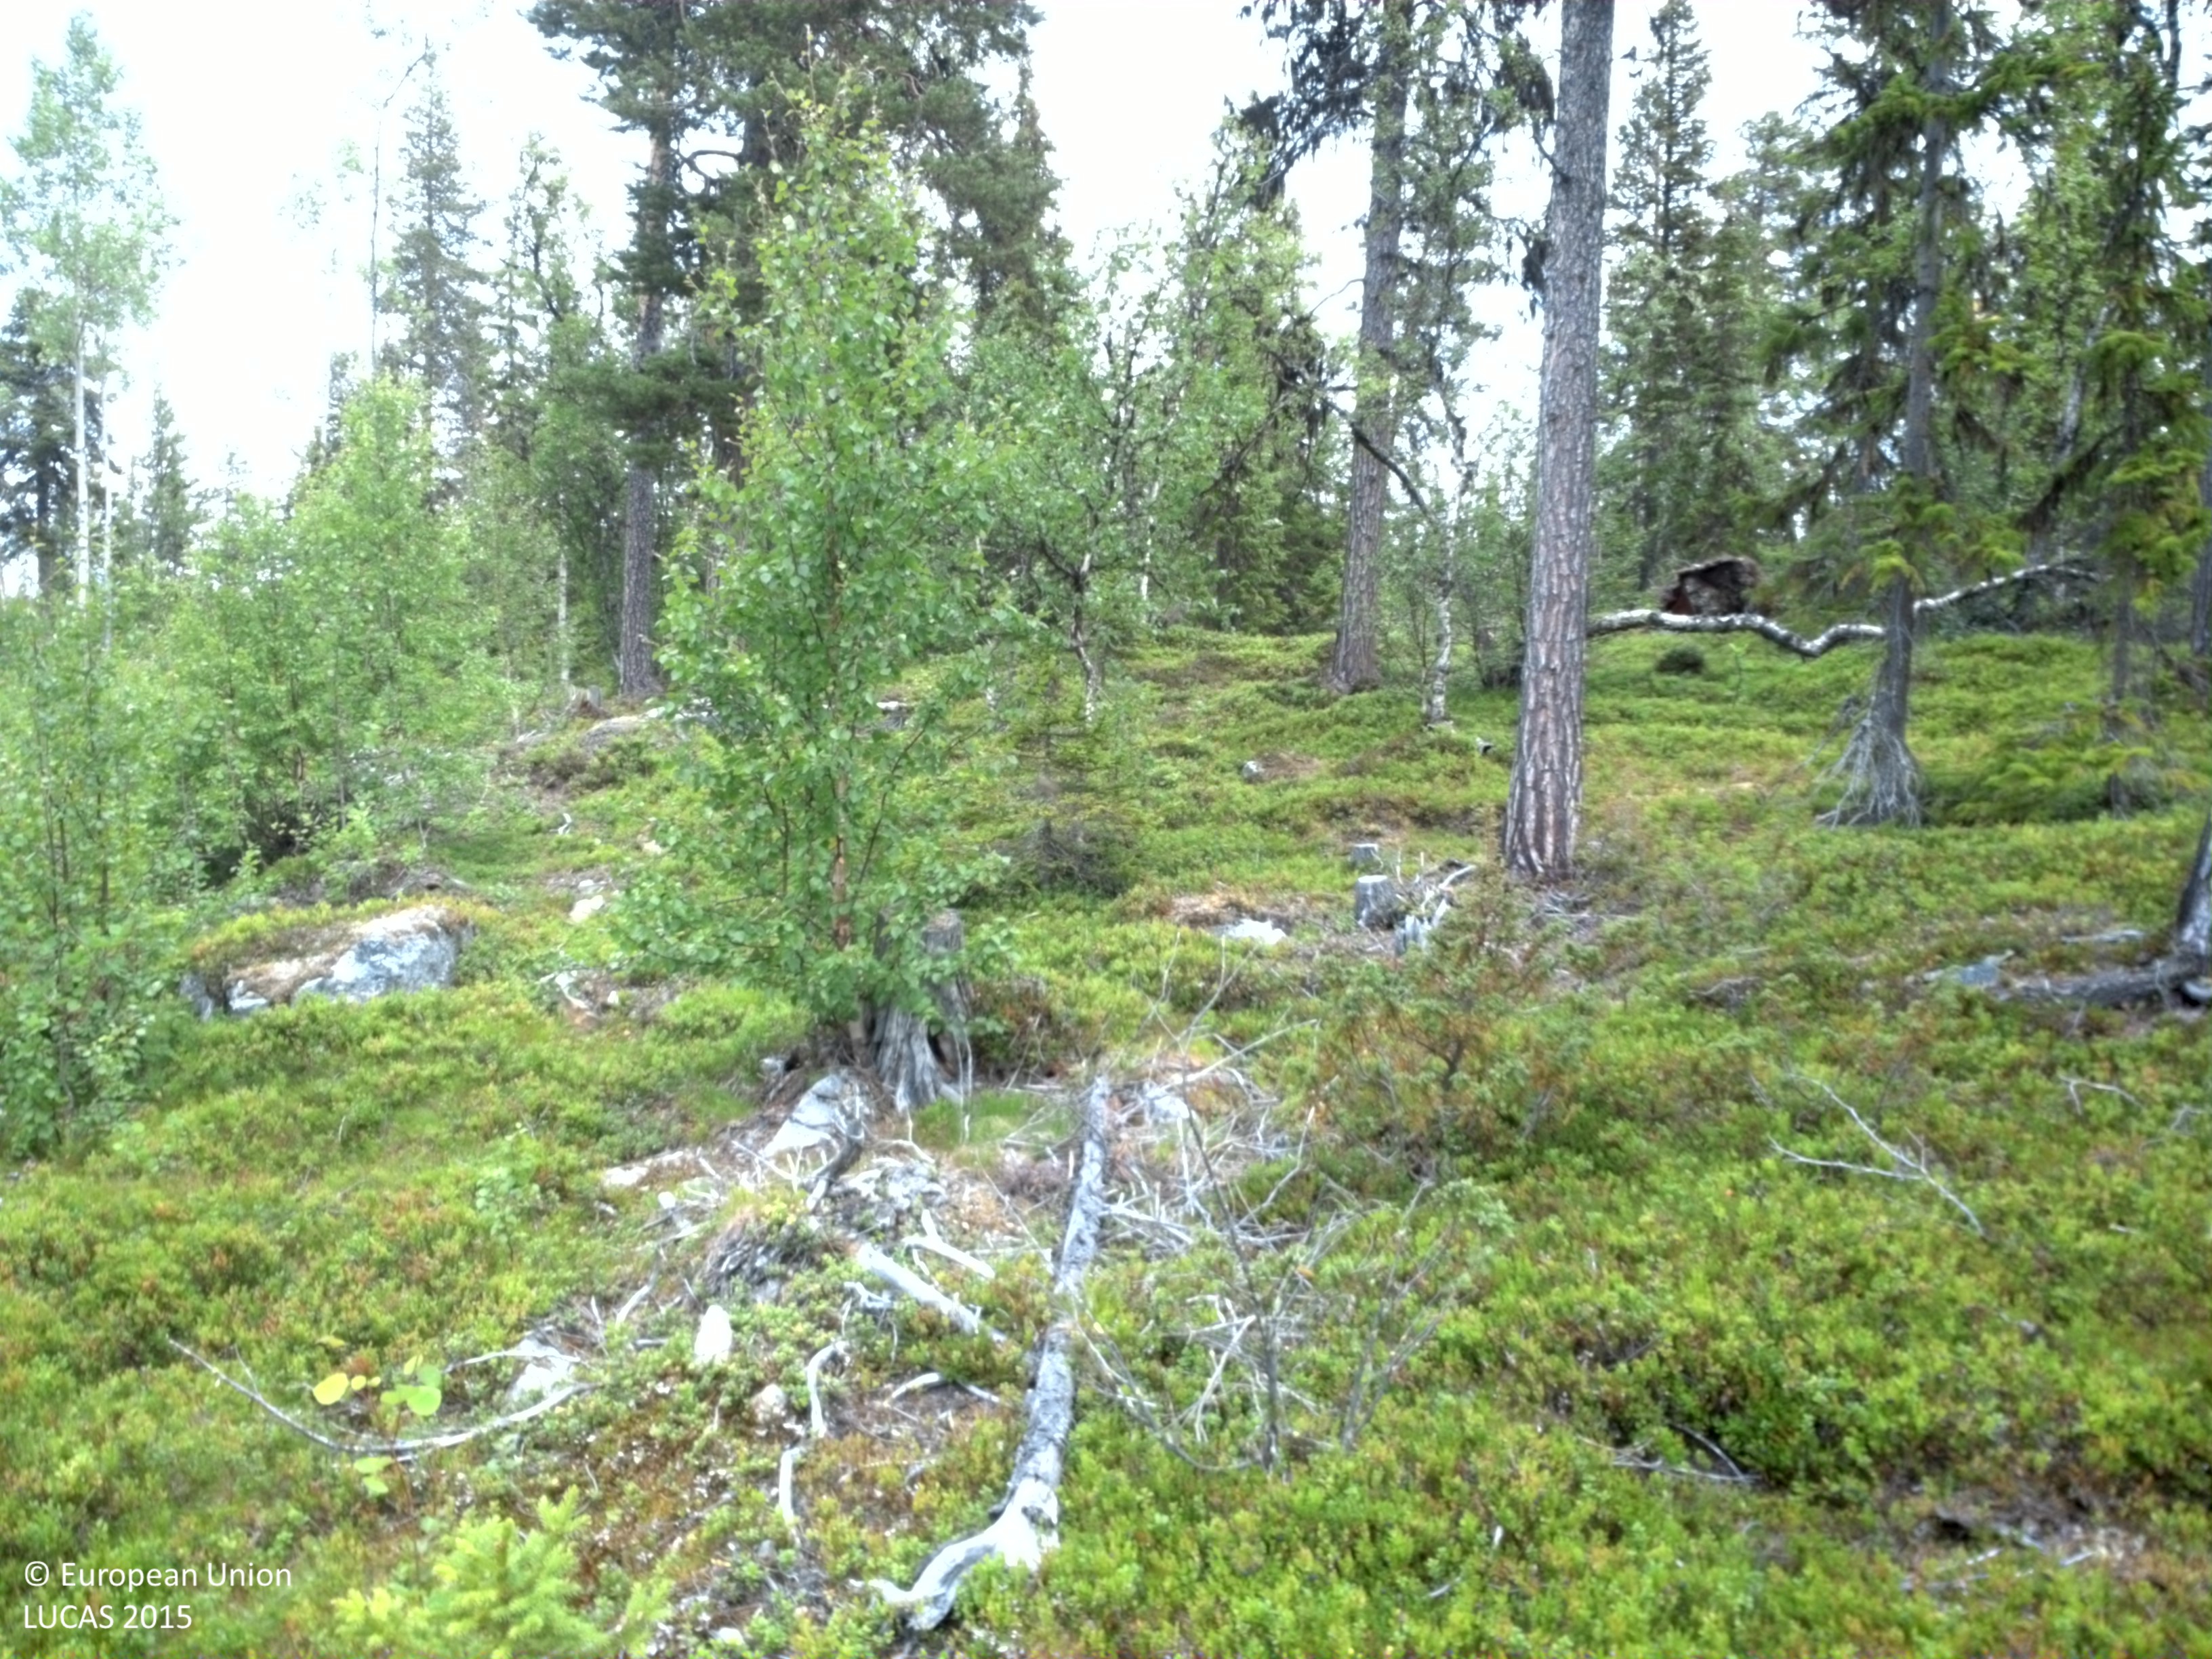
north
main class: Woodland
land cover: Other mixed woodland
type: boreal forest
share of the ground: 10 - 25 %
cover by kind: shrubs 65 %, coniferous forest trees 15 %, lichens and mosses 10 %, broadleaved forest trees 5 %, herbaceous plants 5 %
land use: Forestry
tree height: > 5 m
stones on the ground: < 10 %
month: August
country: SE
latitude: 64.9369
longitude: 15.4897
